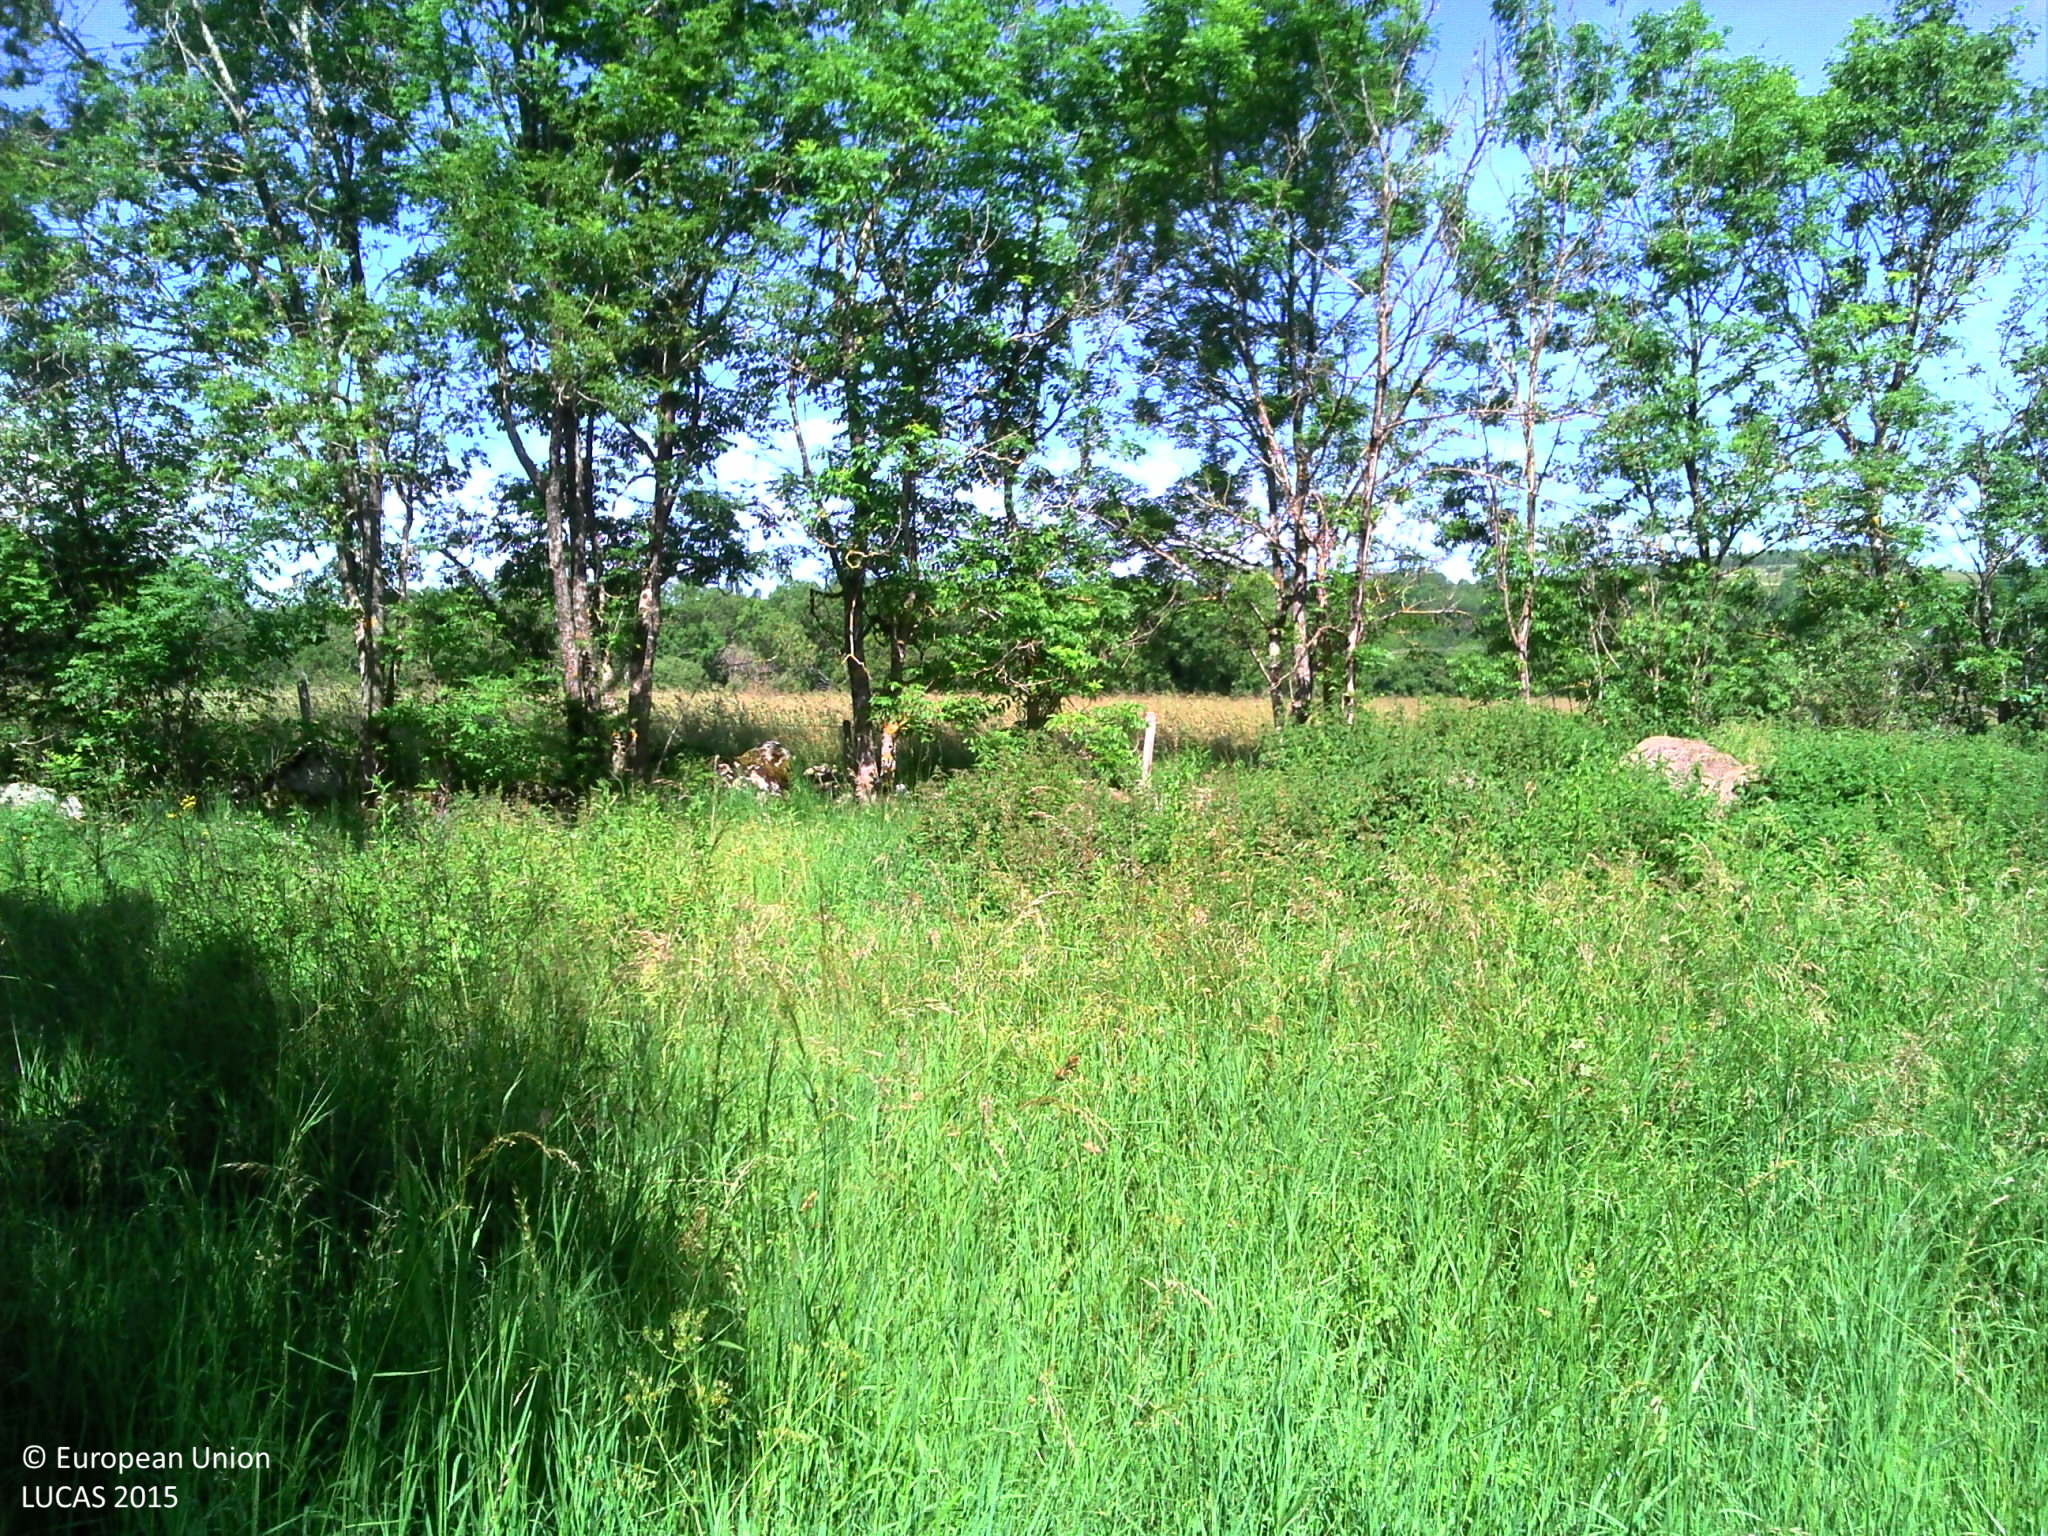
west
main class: Grassland
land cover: Grassland without tree/shrub cover
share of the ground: > 75 %
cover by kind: herbaceous plants 100 %
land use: Agriculture (excluding fallow land and kitchen gardens)
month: June
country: FR
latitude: 44.9947
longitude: 2.9111
